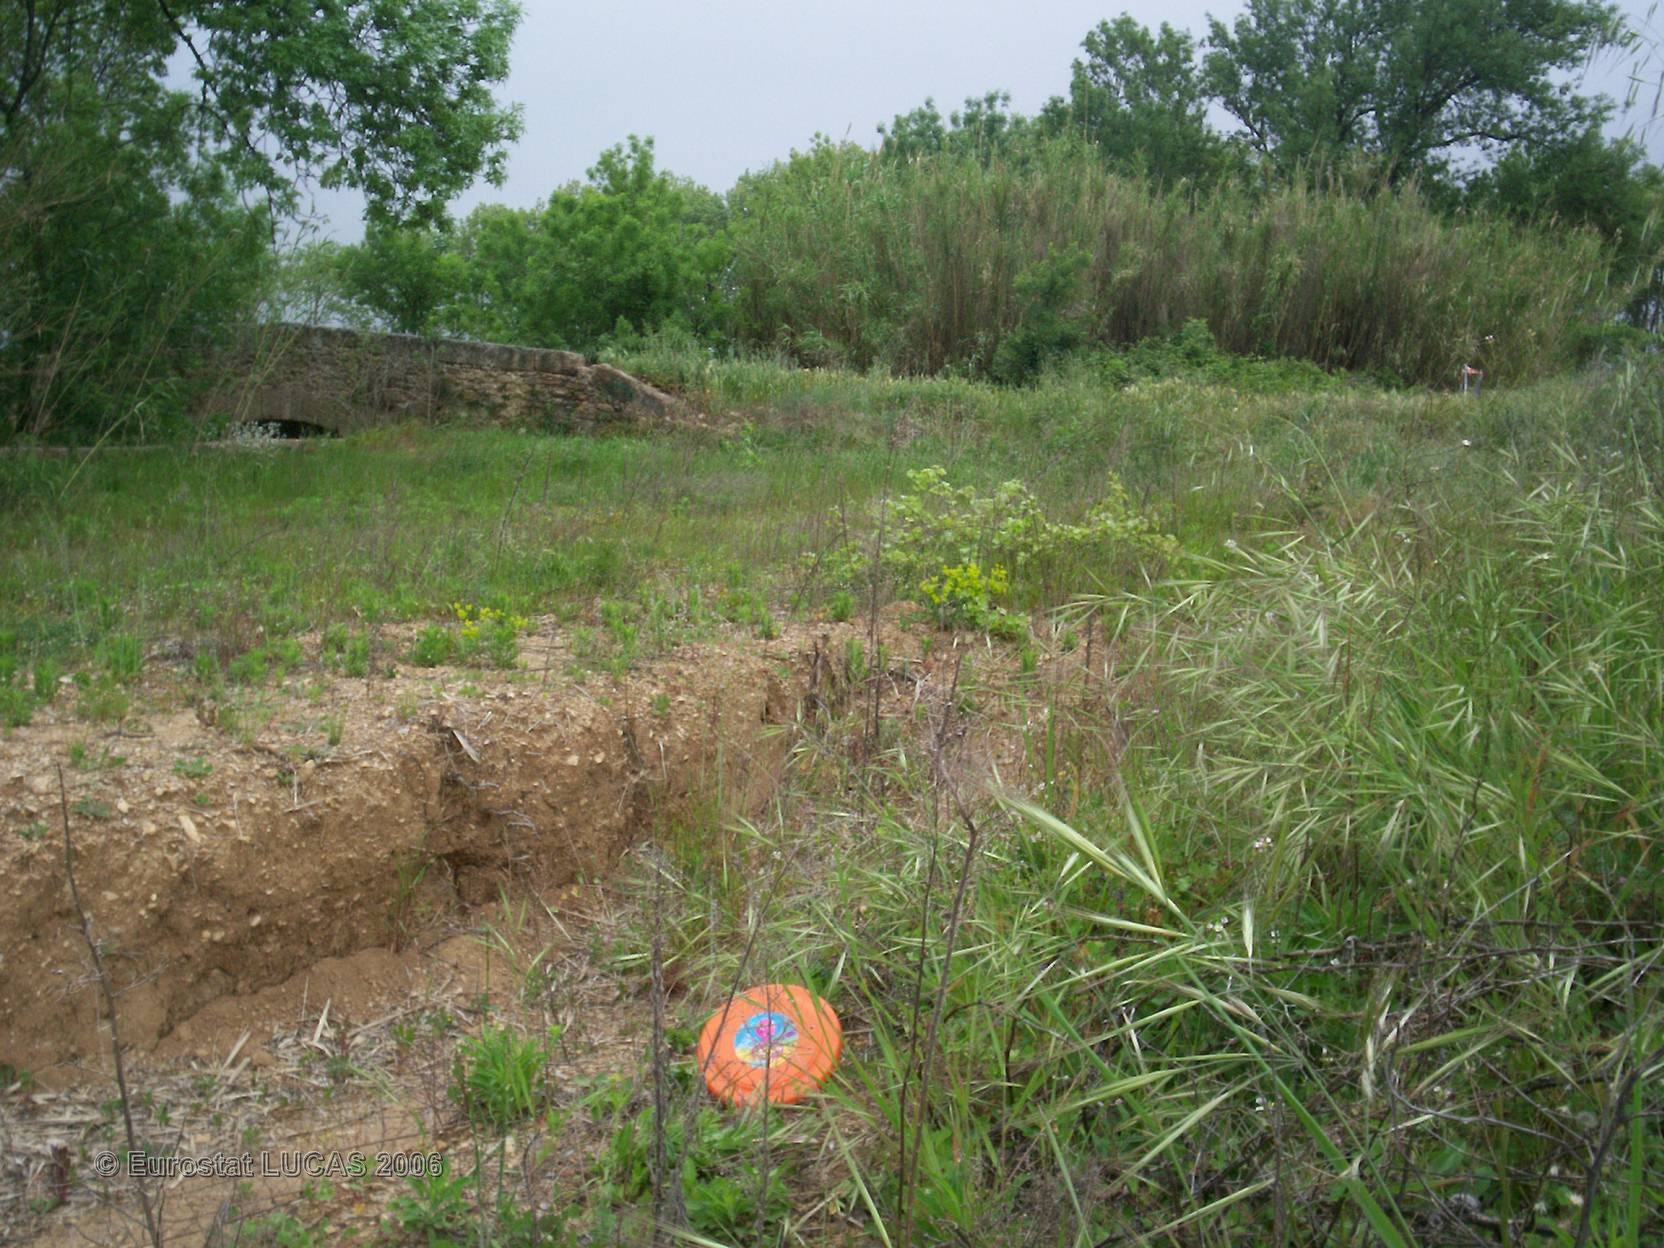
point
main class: Grassland
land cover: Grassland without tree/shrub cover
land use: Agriculture (excluding fallow land and kitchen gardens)
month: May
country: FR
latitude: 43.6565
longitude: 3.4739
